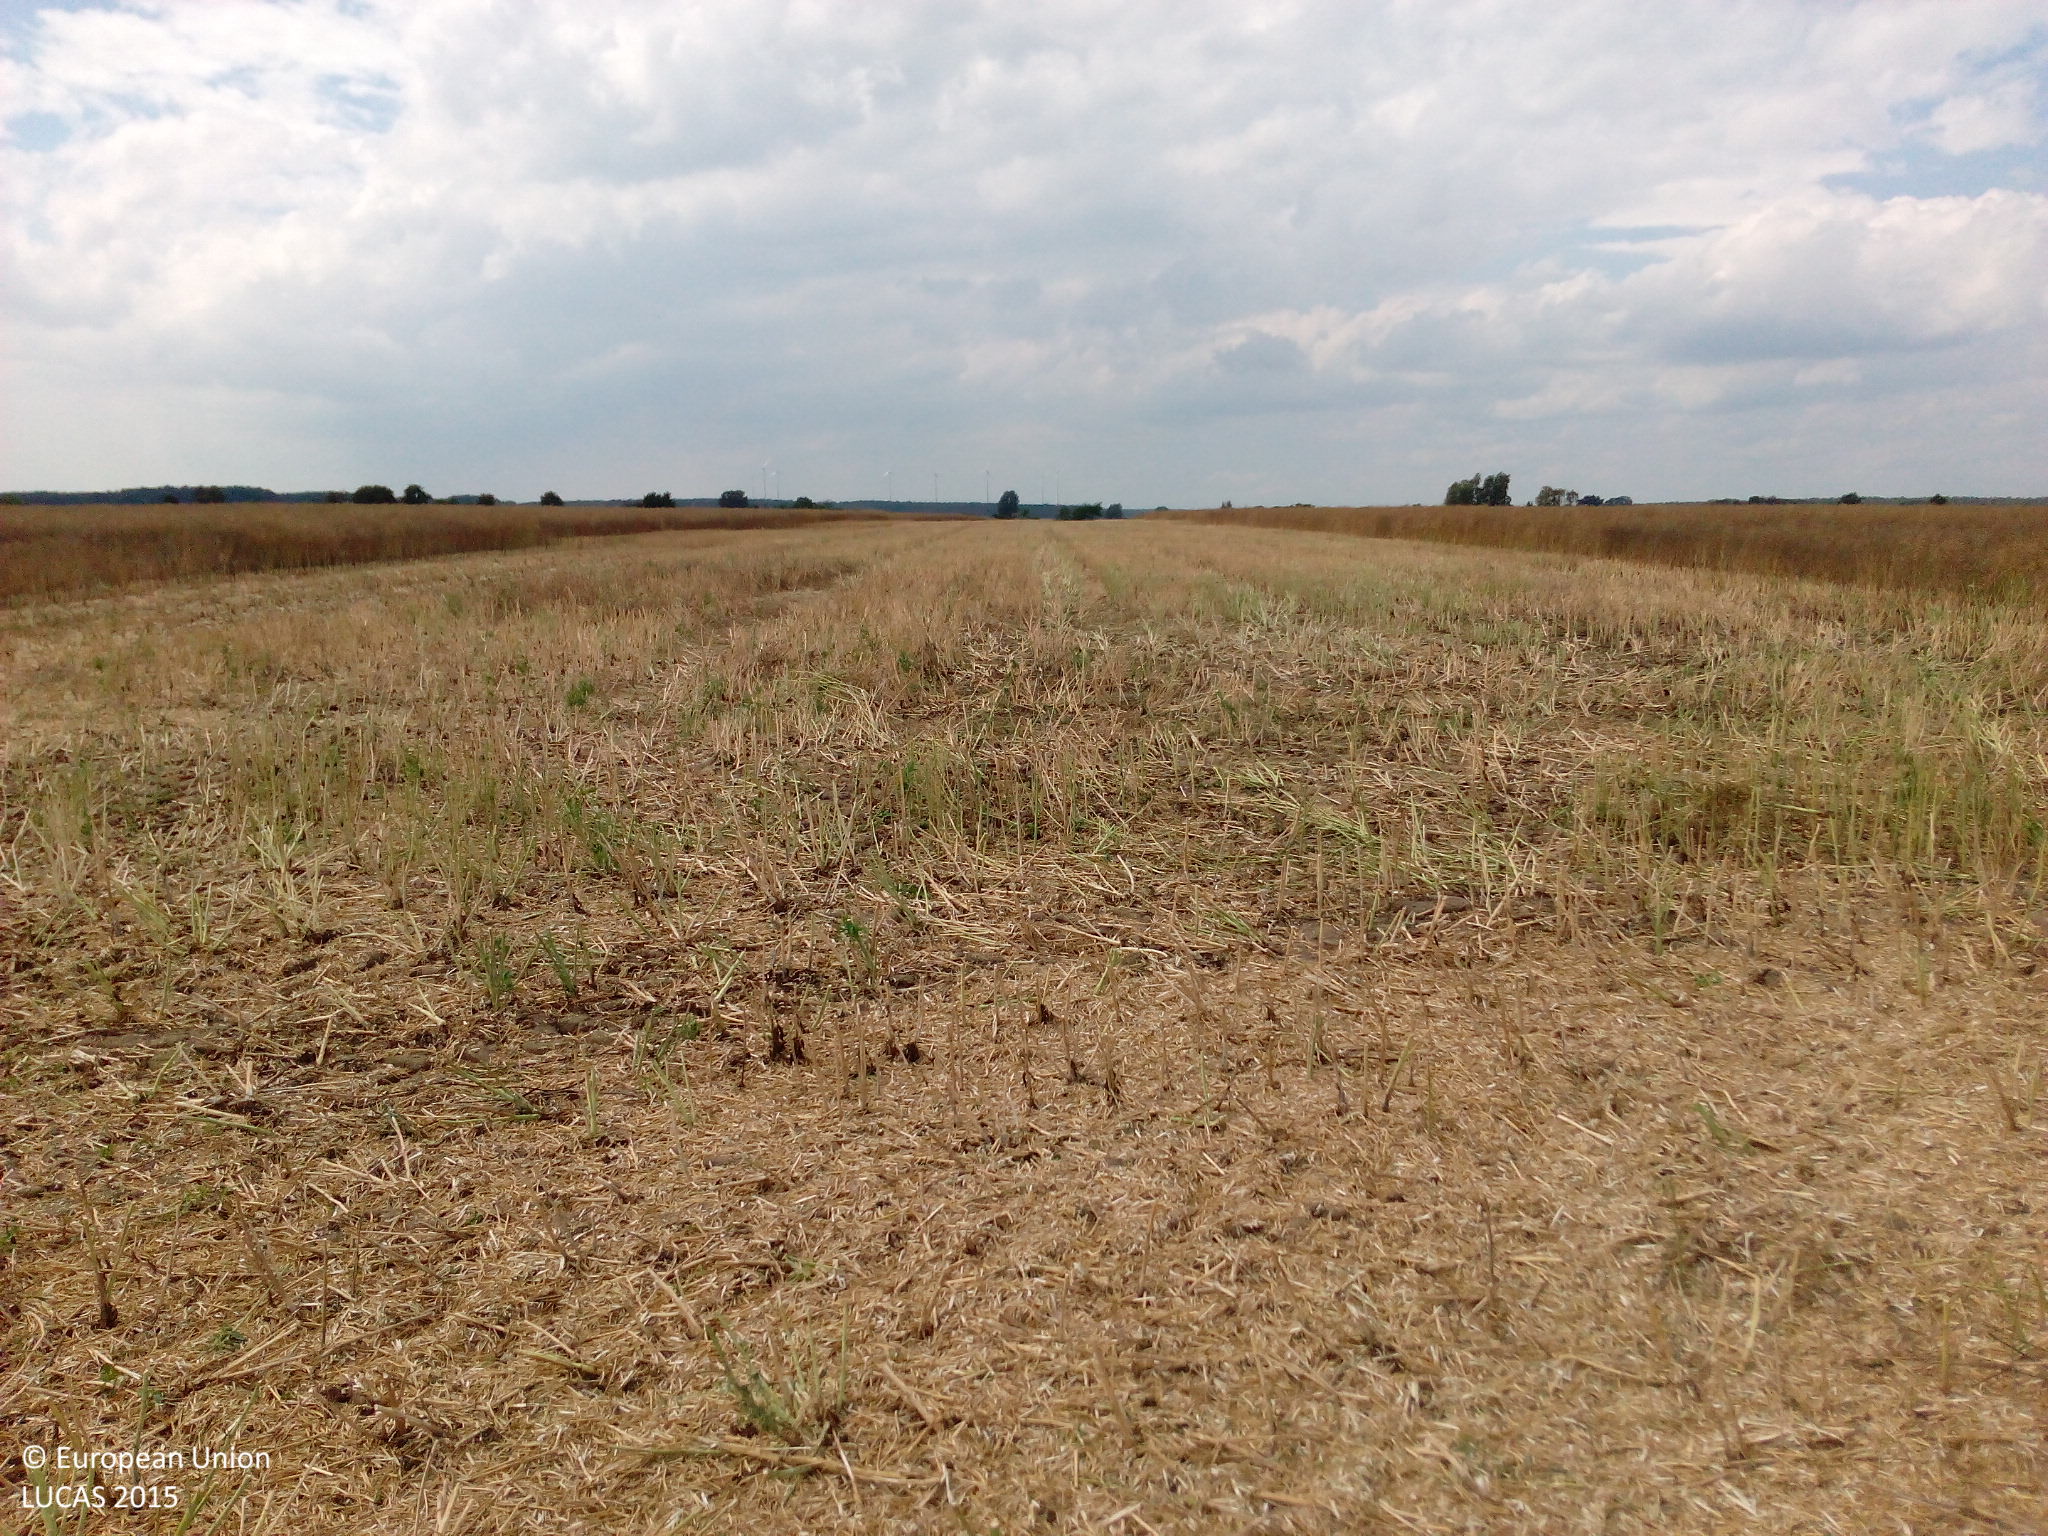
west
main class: Cropland
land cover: Rye
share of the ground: > 75 %
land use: Agriculture (excluding fallow land and kitchen gardens)
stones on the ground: < 10 %
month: July
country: DE
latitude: 52.2701
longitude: 12.0365
